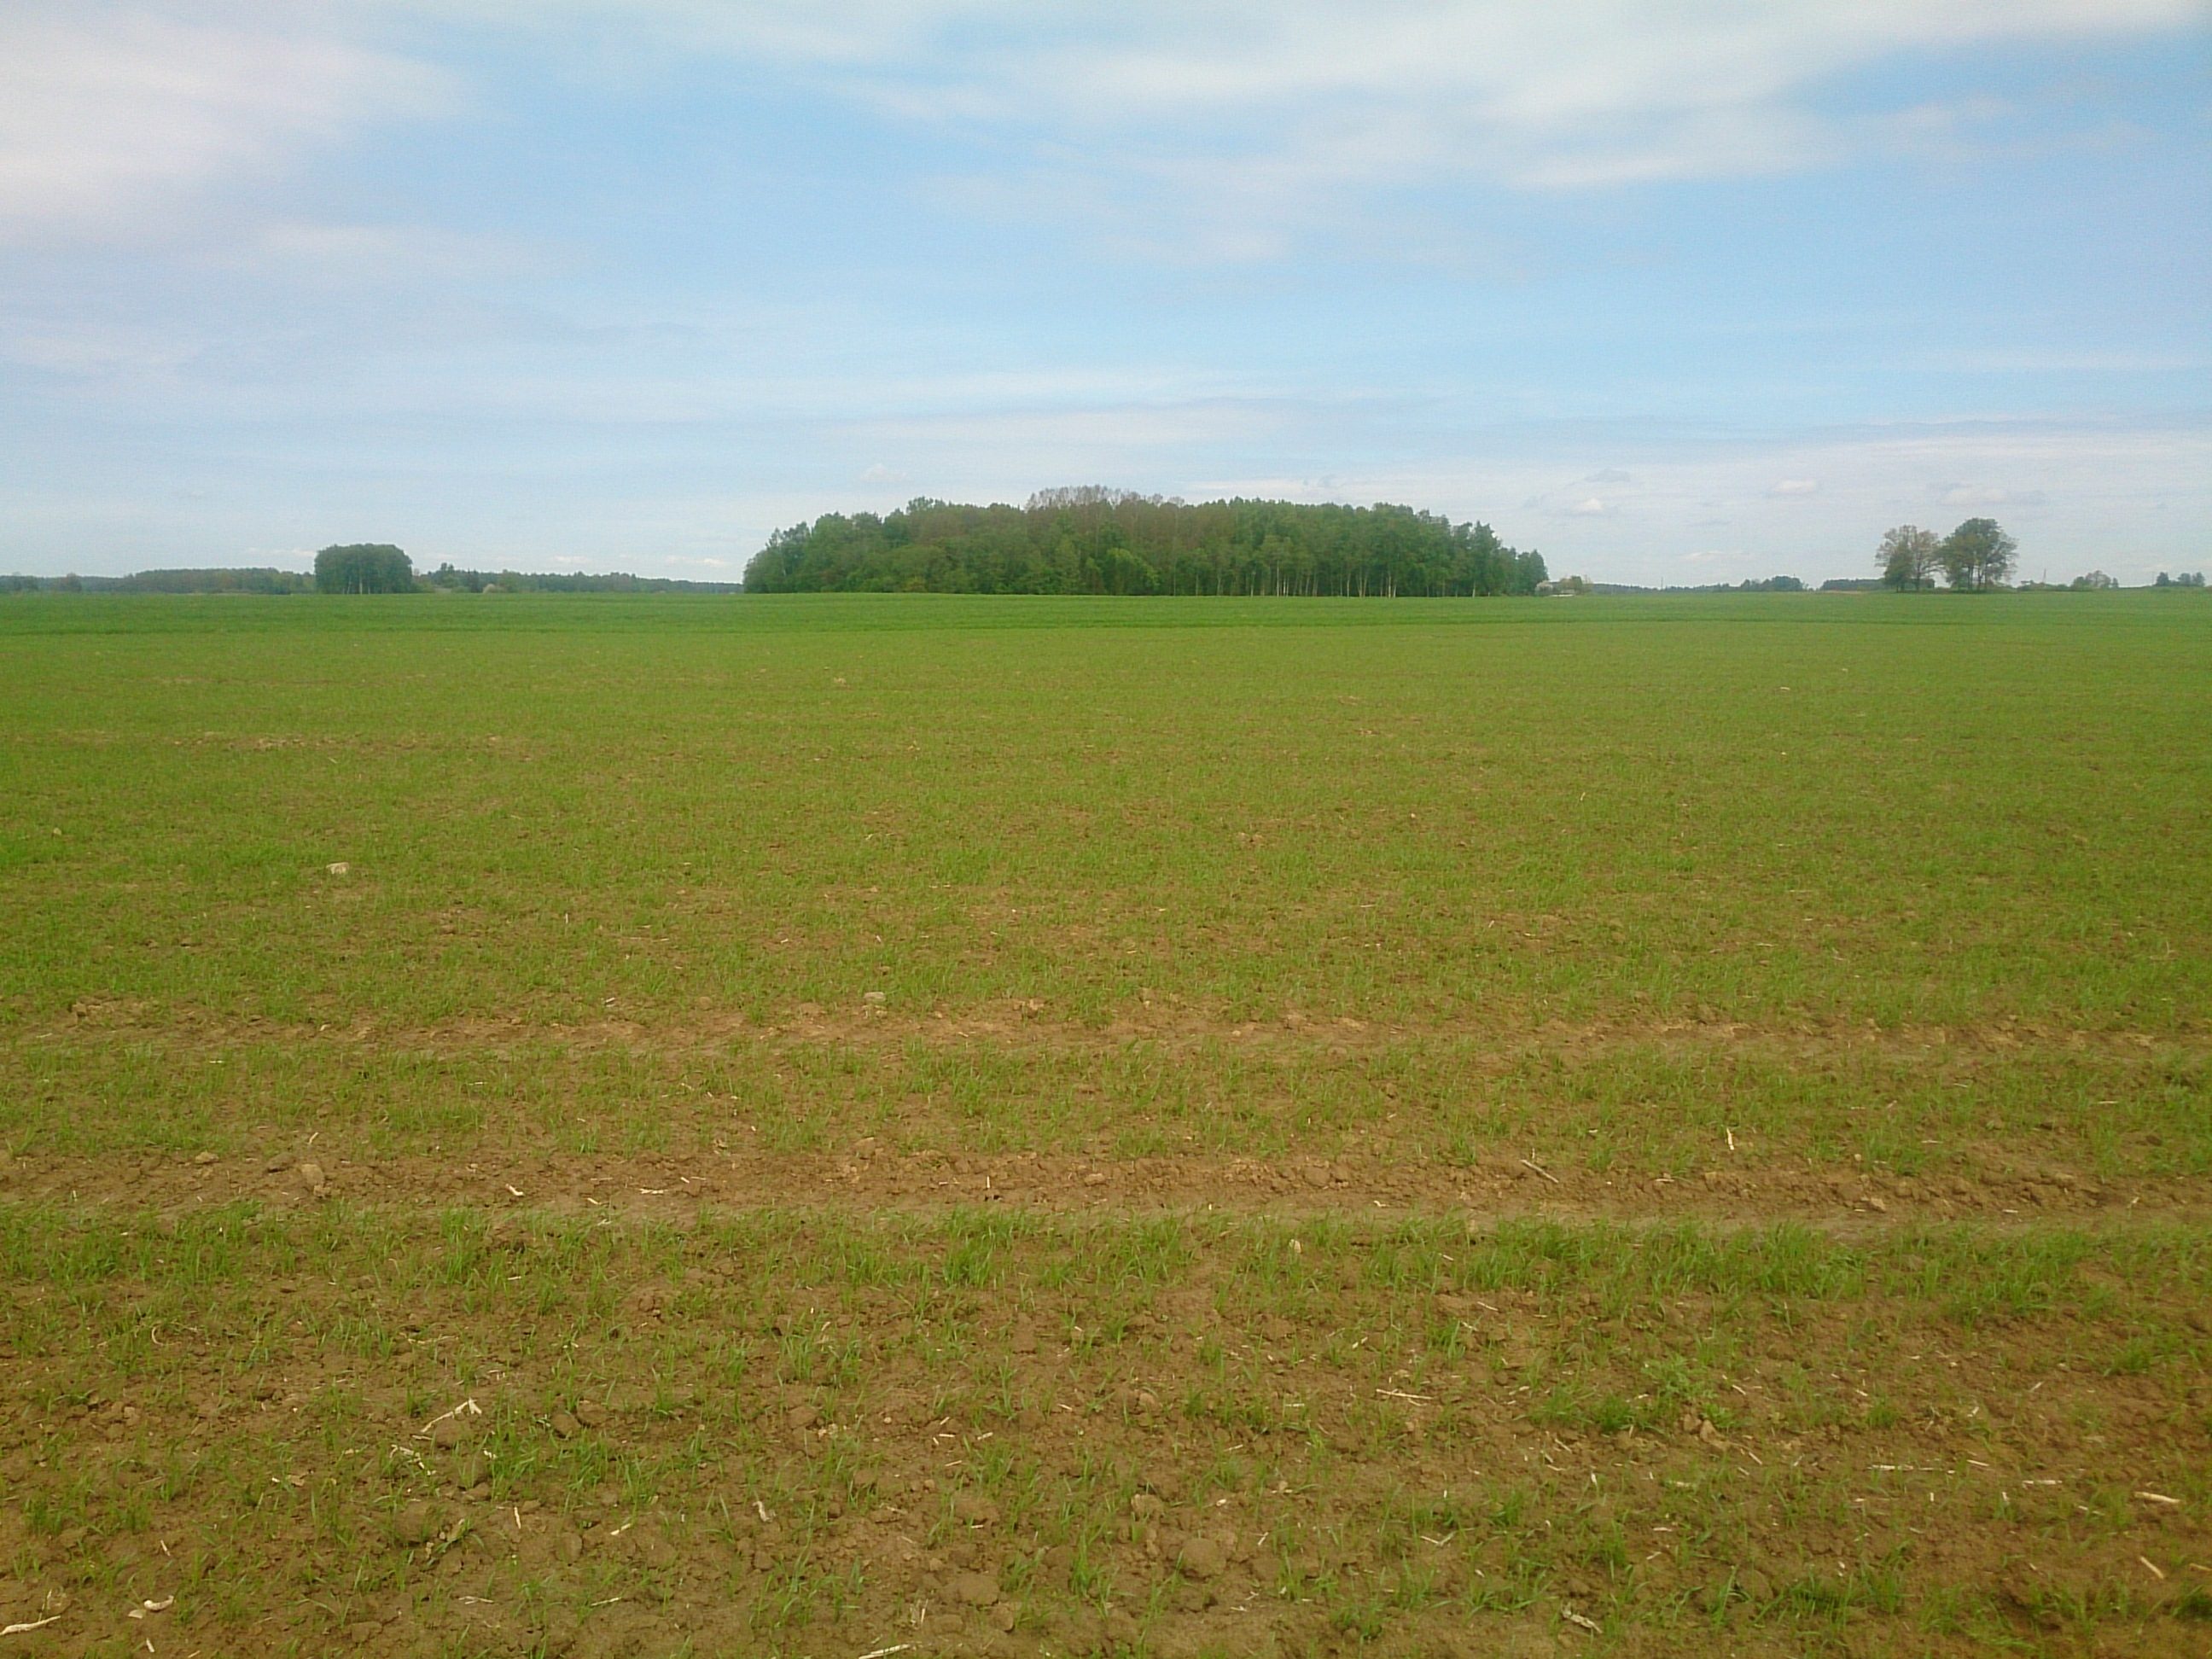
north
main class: Cropland
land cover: Common wheat
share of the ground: 50 - 75 %
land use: Agriculture (excluding fallow land and kitchen gardens)
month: May
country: LV
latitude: 56.5143
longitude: 24.1456
